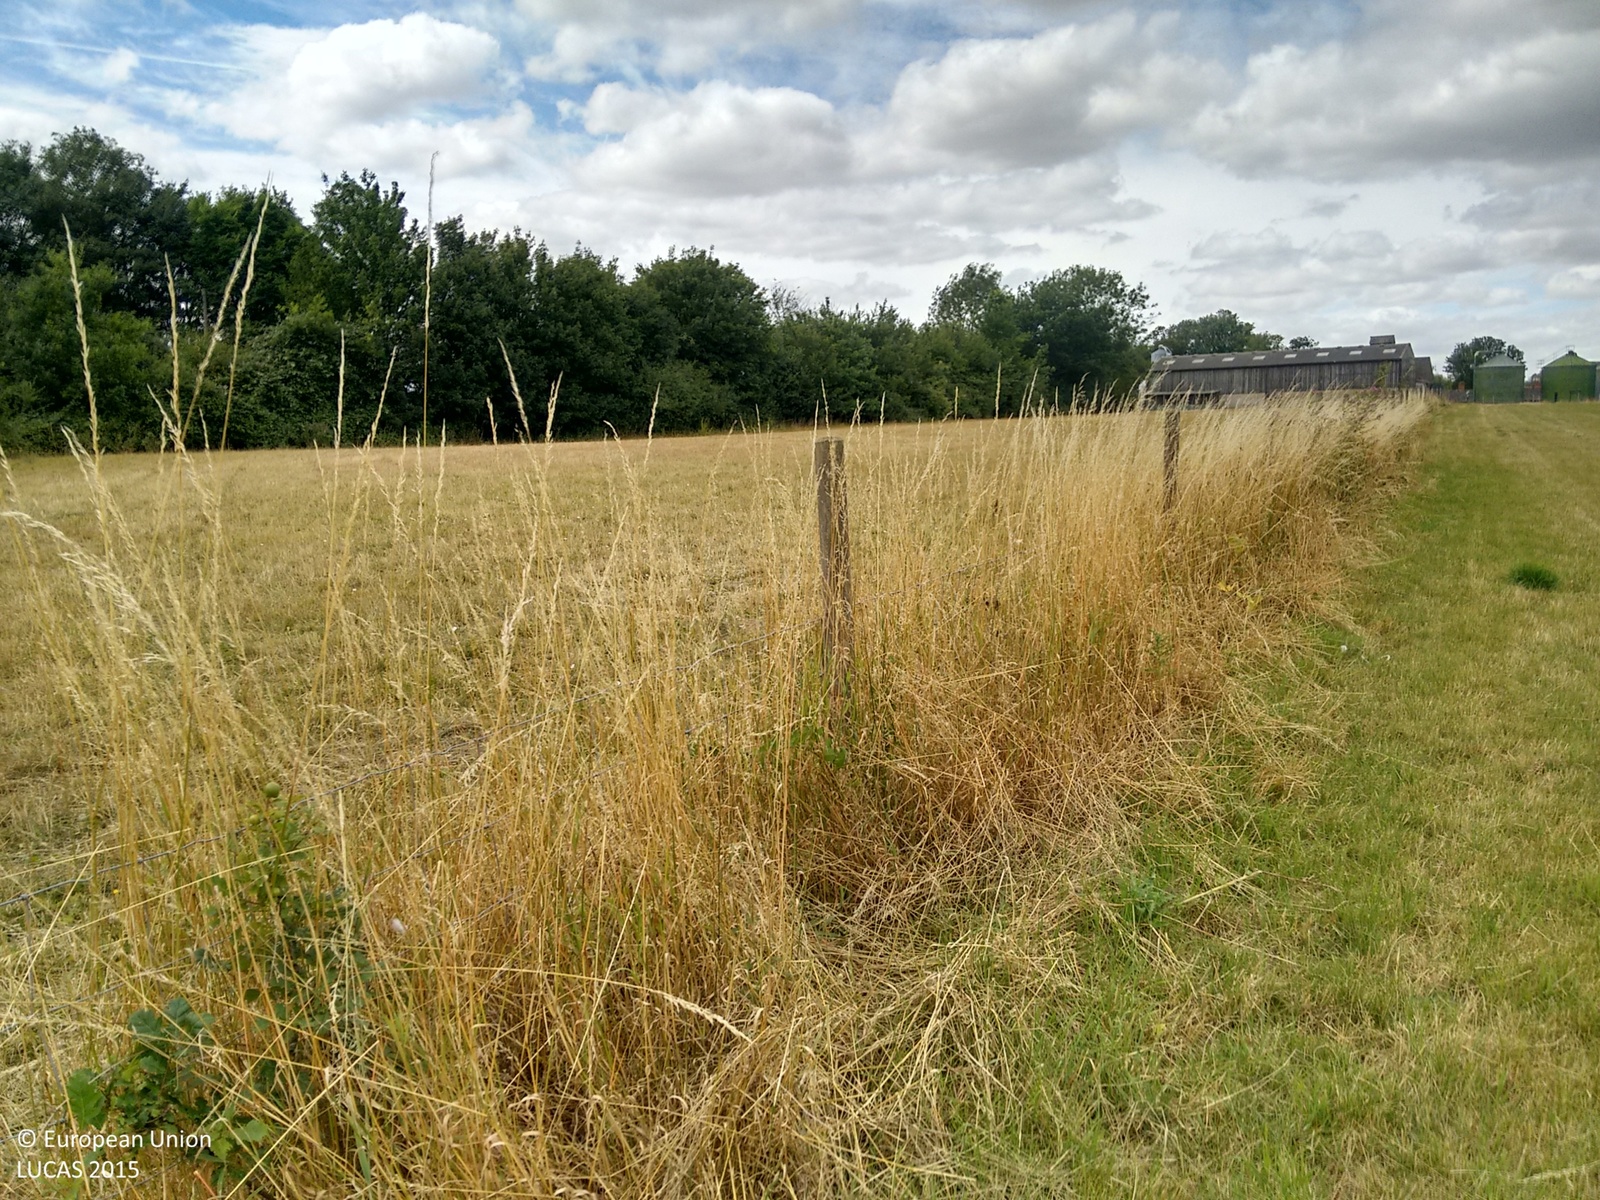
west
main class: Grassland
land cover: Grassland without tree/shrub cover
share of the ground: > 75 %
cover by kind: herbaceous plants 100 %
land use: Agriculture (excluding fallow land and kitchen gardens)
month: August
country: GB
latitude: 51.9678
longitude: 0.3791
